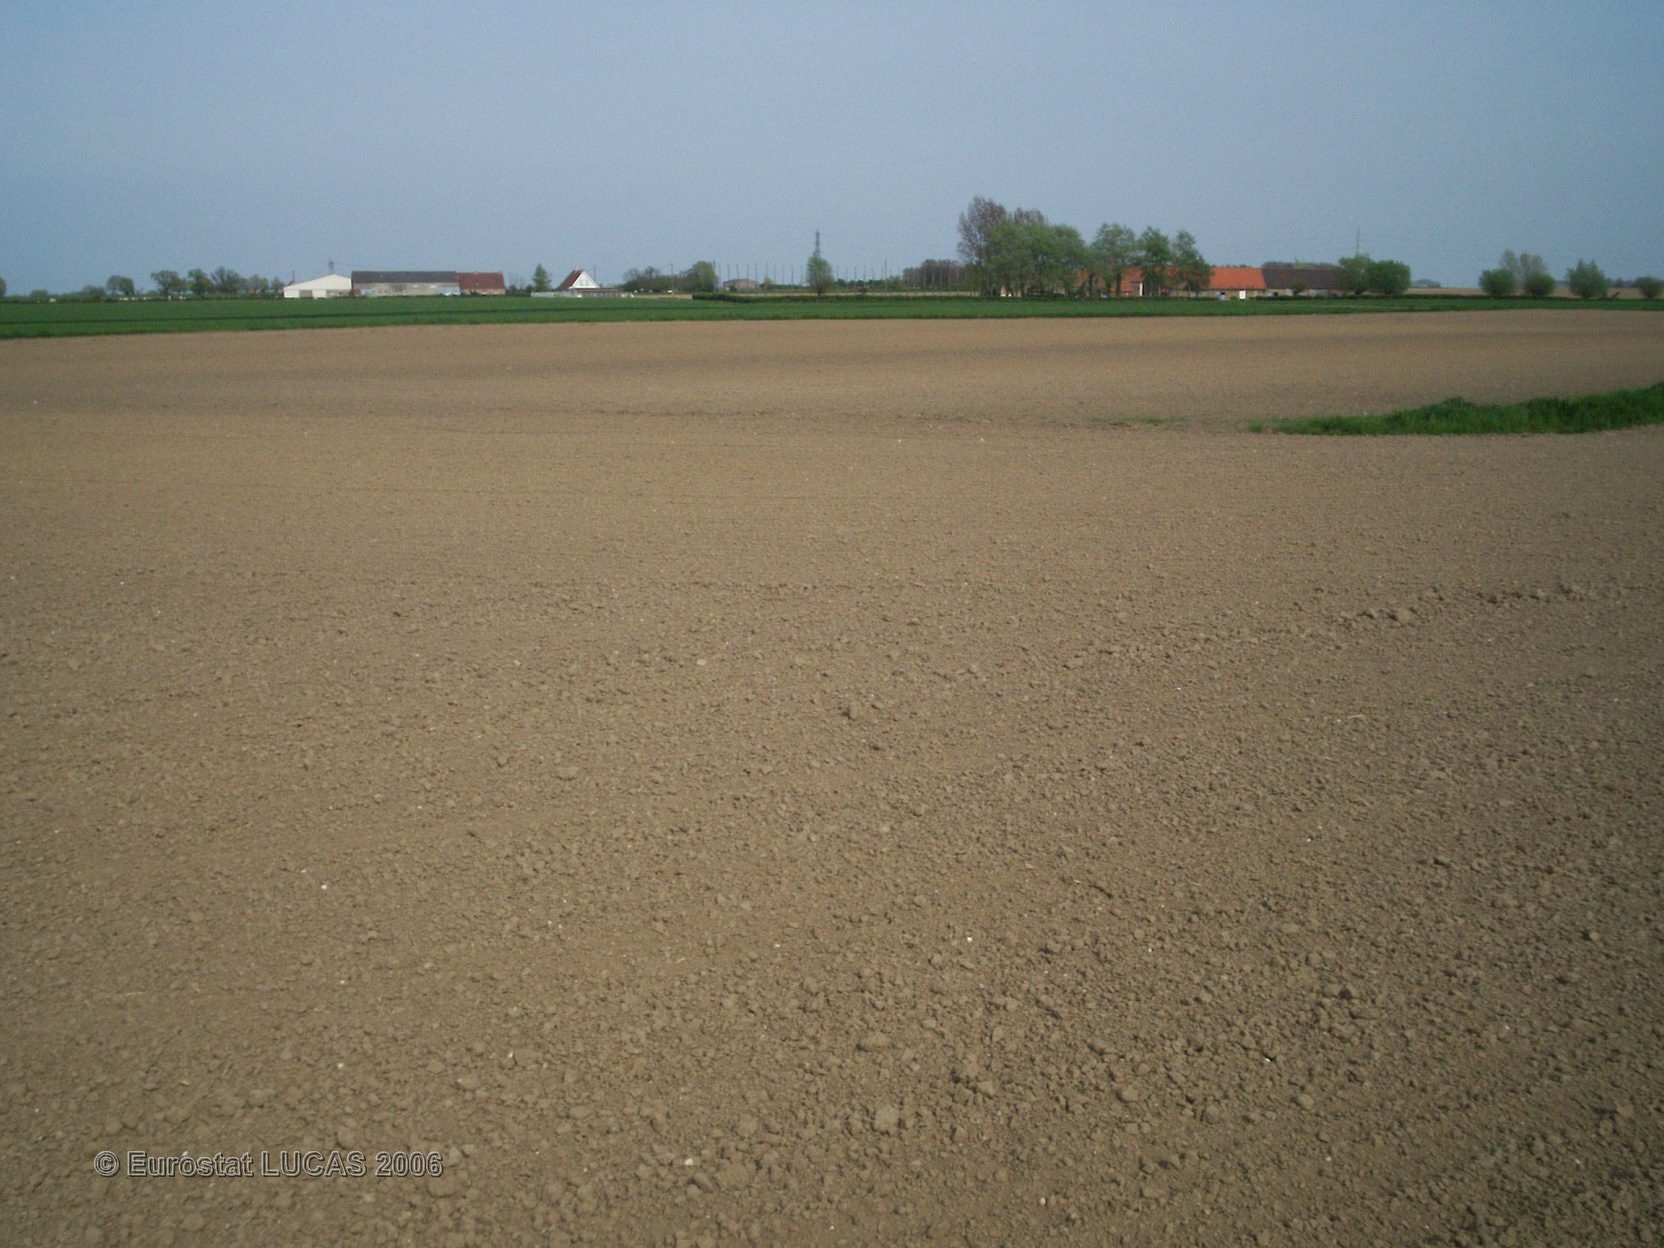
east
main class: Cropland
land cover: Dry pulses
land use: Agriculture (excluding fallow land and kitchen gardens)
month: May
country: FR
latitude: 50.9475
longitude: 2.4860
